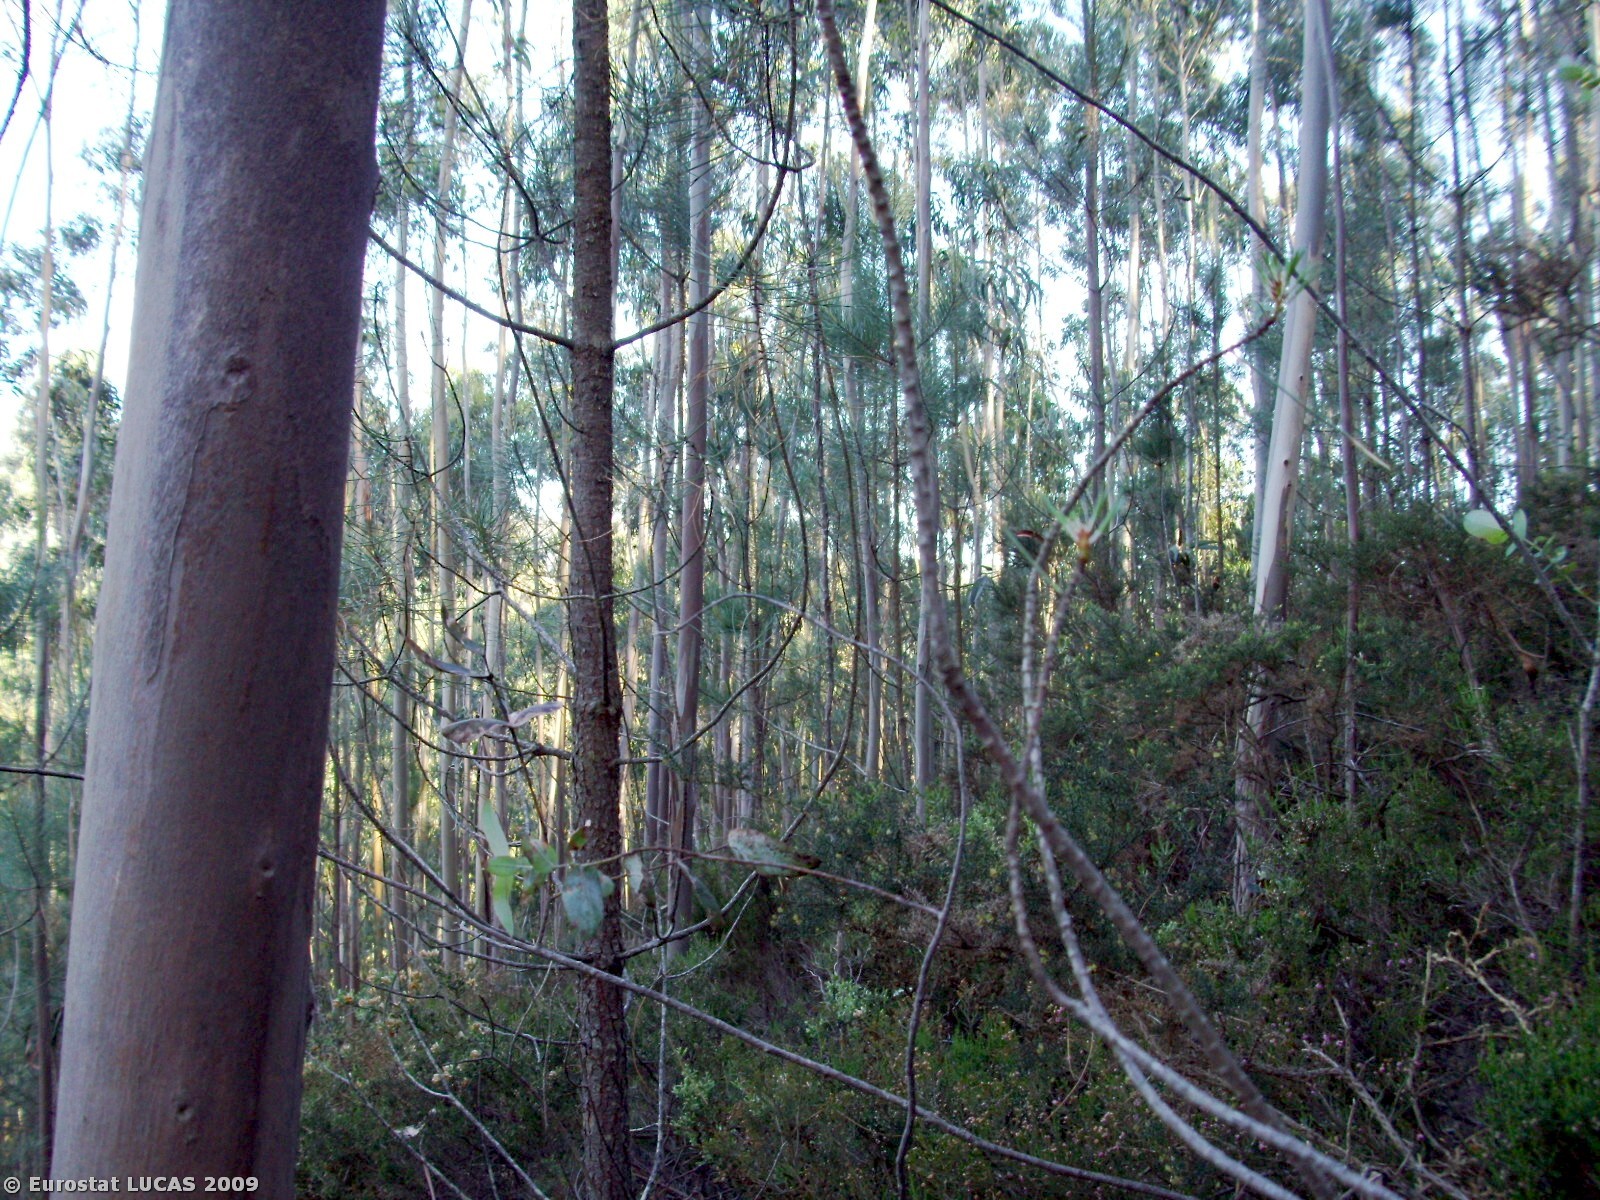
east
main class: Woodland
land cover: Broadleaved woodland
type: plantations and self-sown exotic forest
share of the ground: > 75 %
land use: Forestry
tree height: > 5 m
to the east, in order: Broadleaved woodland; Tracks; Broadleaved woodland; Tracks; Broadleaved woodland; Tracks; Broadleaved woodland
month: May
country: PT
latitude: 40.7408
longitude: -8.4366
